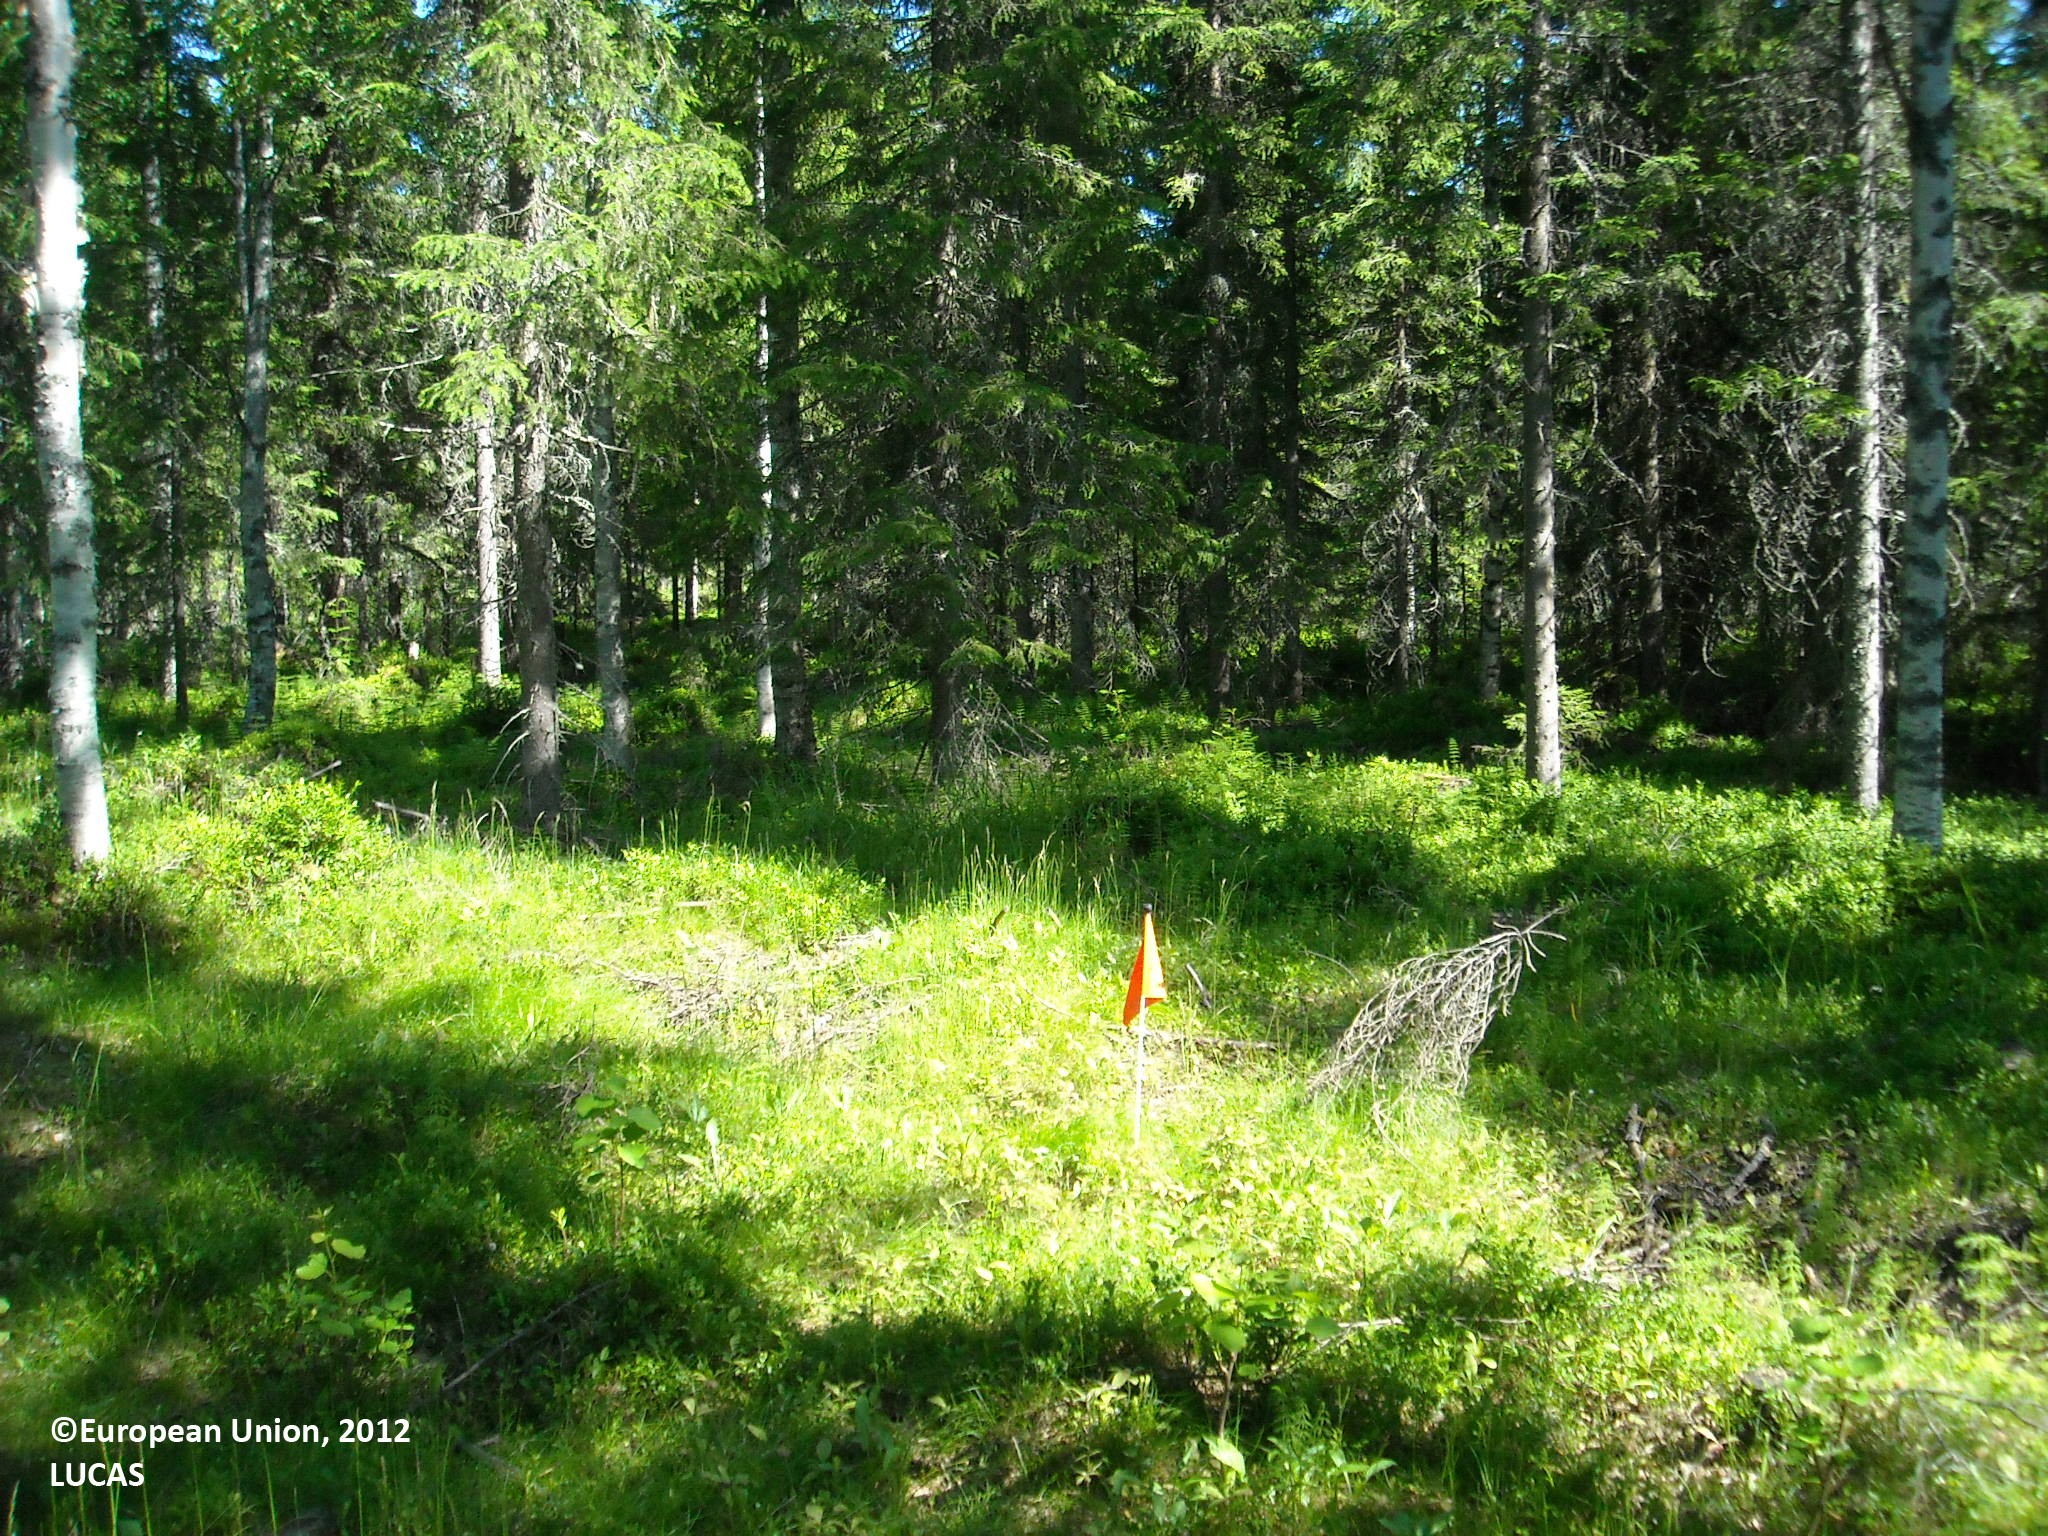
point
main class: Woodland
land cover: Spruce dominated mixed woodland
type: boreal forest
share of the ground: > 75 %
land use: Forestry
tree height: > 5 m
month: July
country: FI
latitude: 64.6761
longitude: 27.8576
